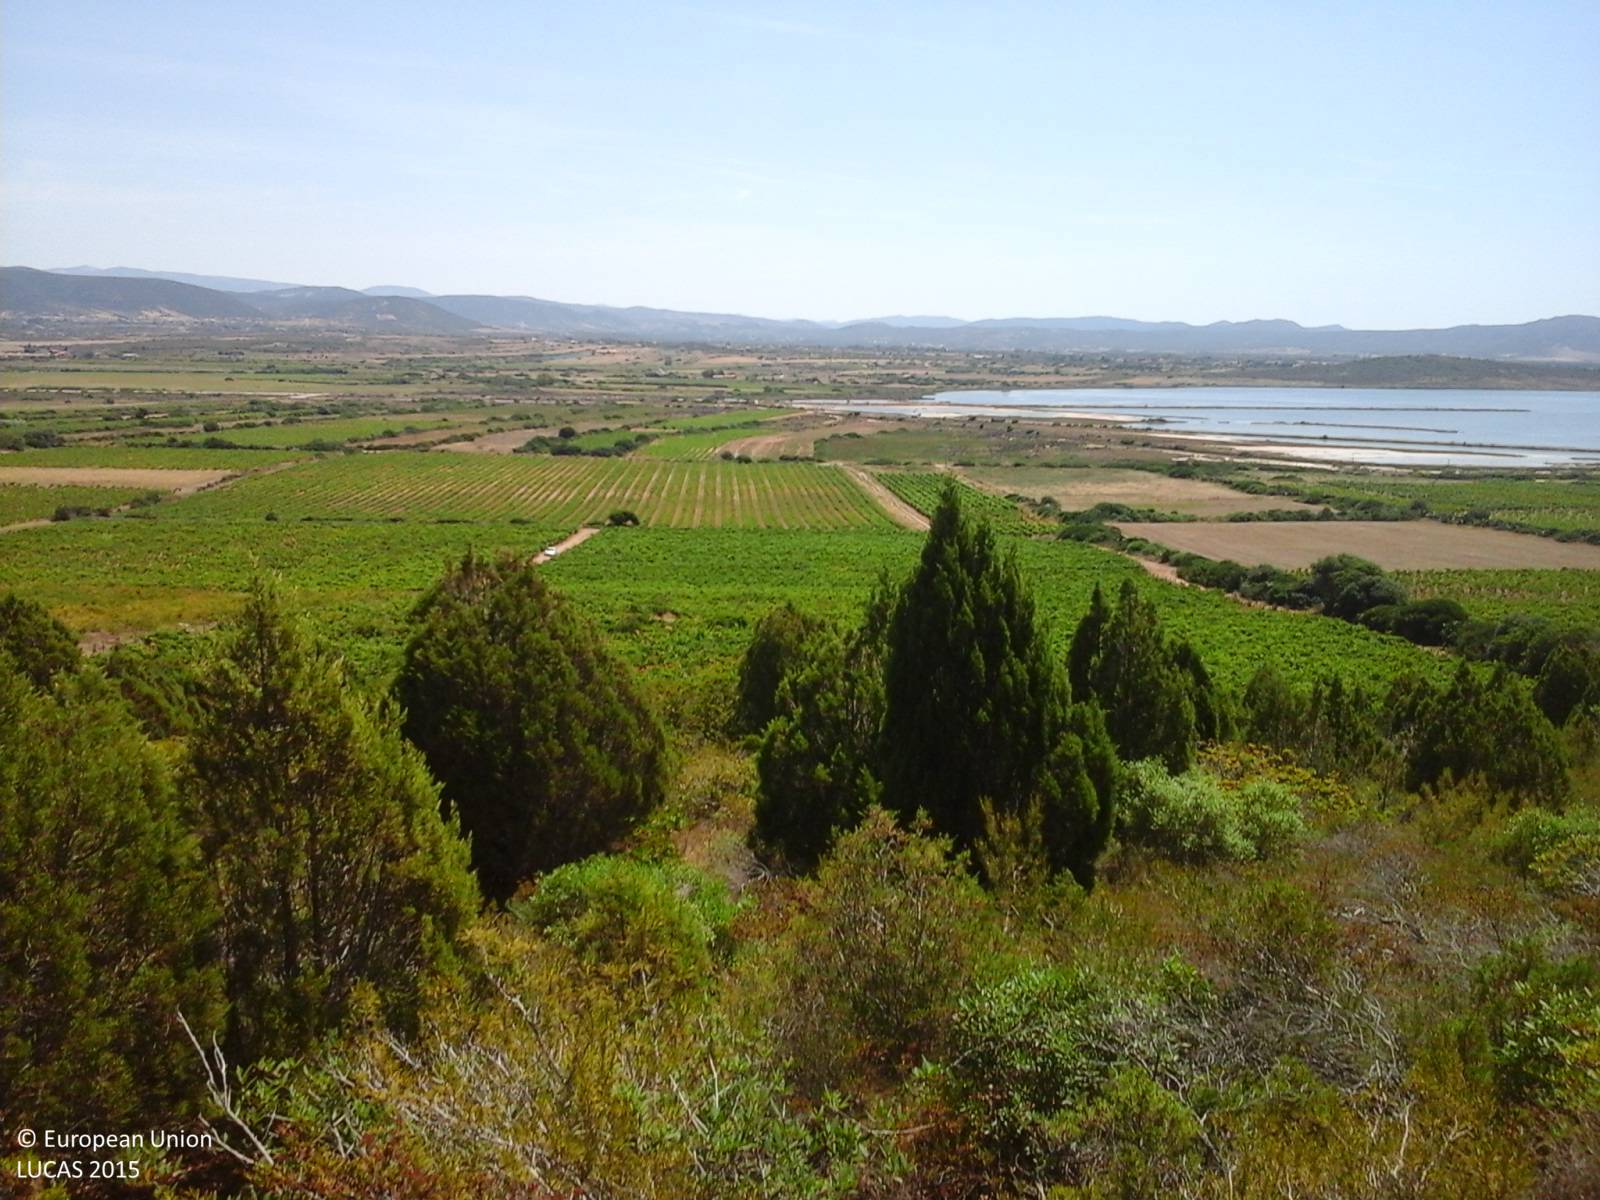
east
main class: Woodland
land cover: Other coniferous woodland
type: coniferous forest of the mediterranean region
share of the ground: > 75 %
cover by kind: coniferous forest trees 70 %, shrubs 15 %, herbaceous plants 10 %, unconsolidated bare surface 5 %
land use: Forestry
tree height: < 5 m
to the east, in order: Other coniferous woodland; Shrubland with sparse tree cover; Tracks; Abandoned hedges; Vineyards
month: June
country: IT
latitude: 38.9890
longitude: 8.5890
